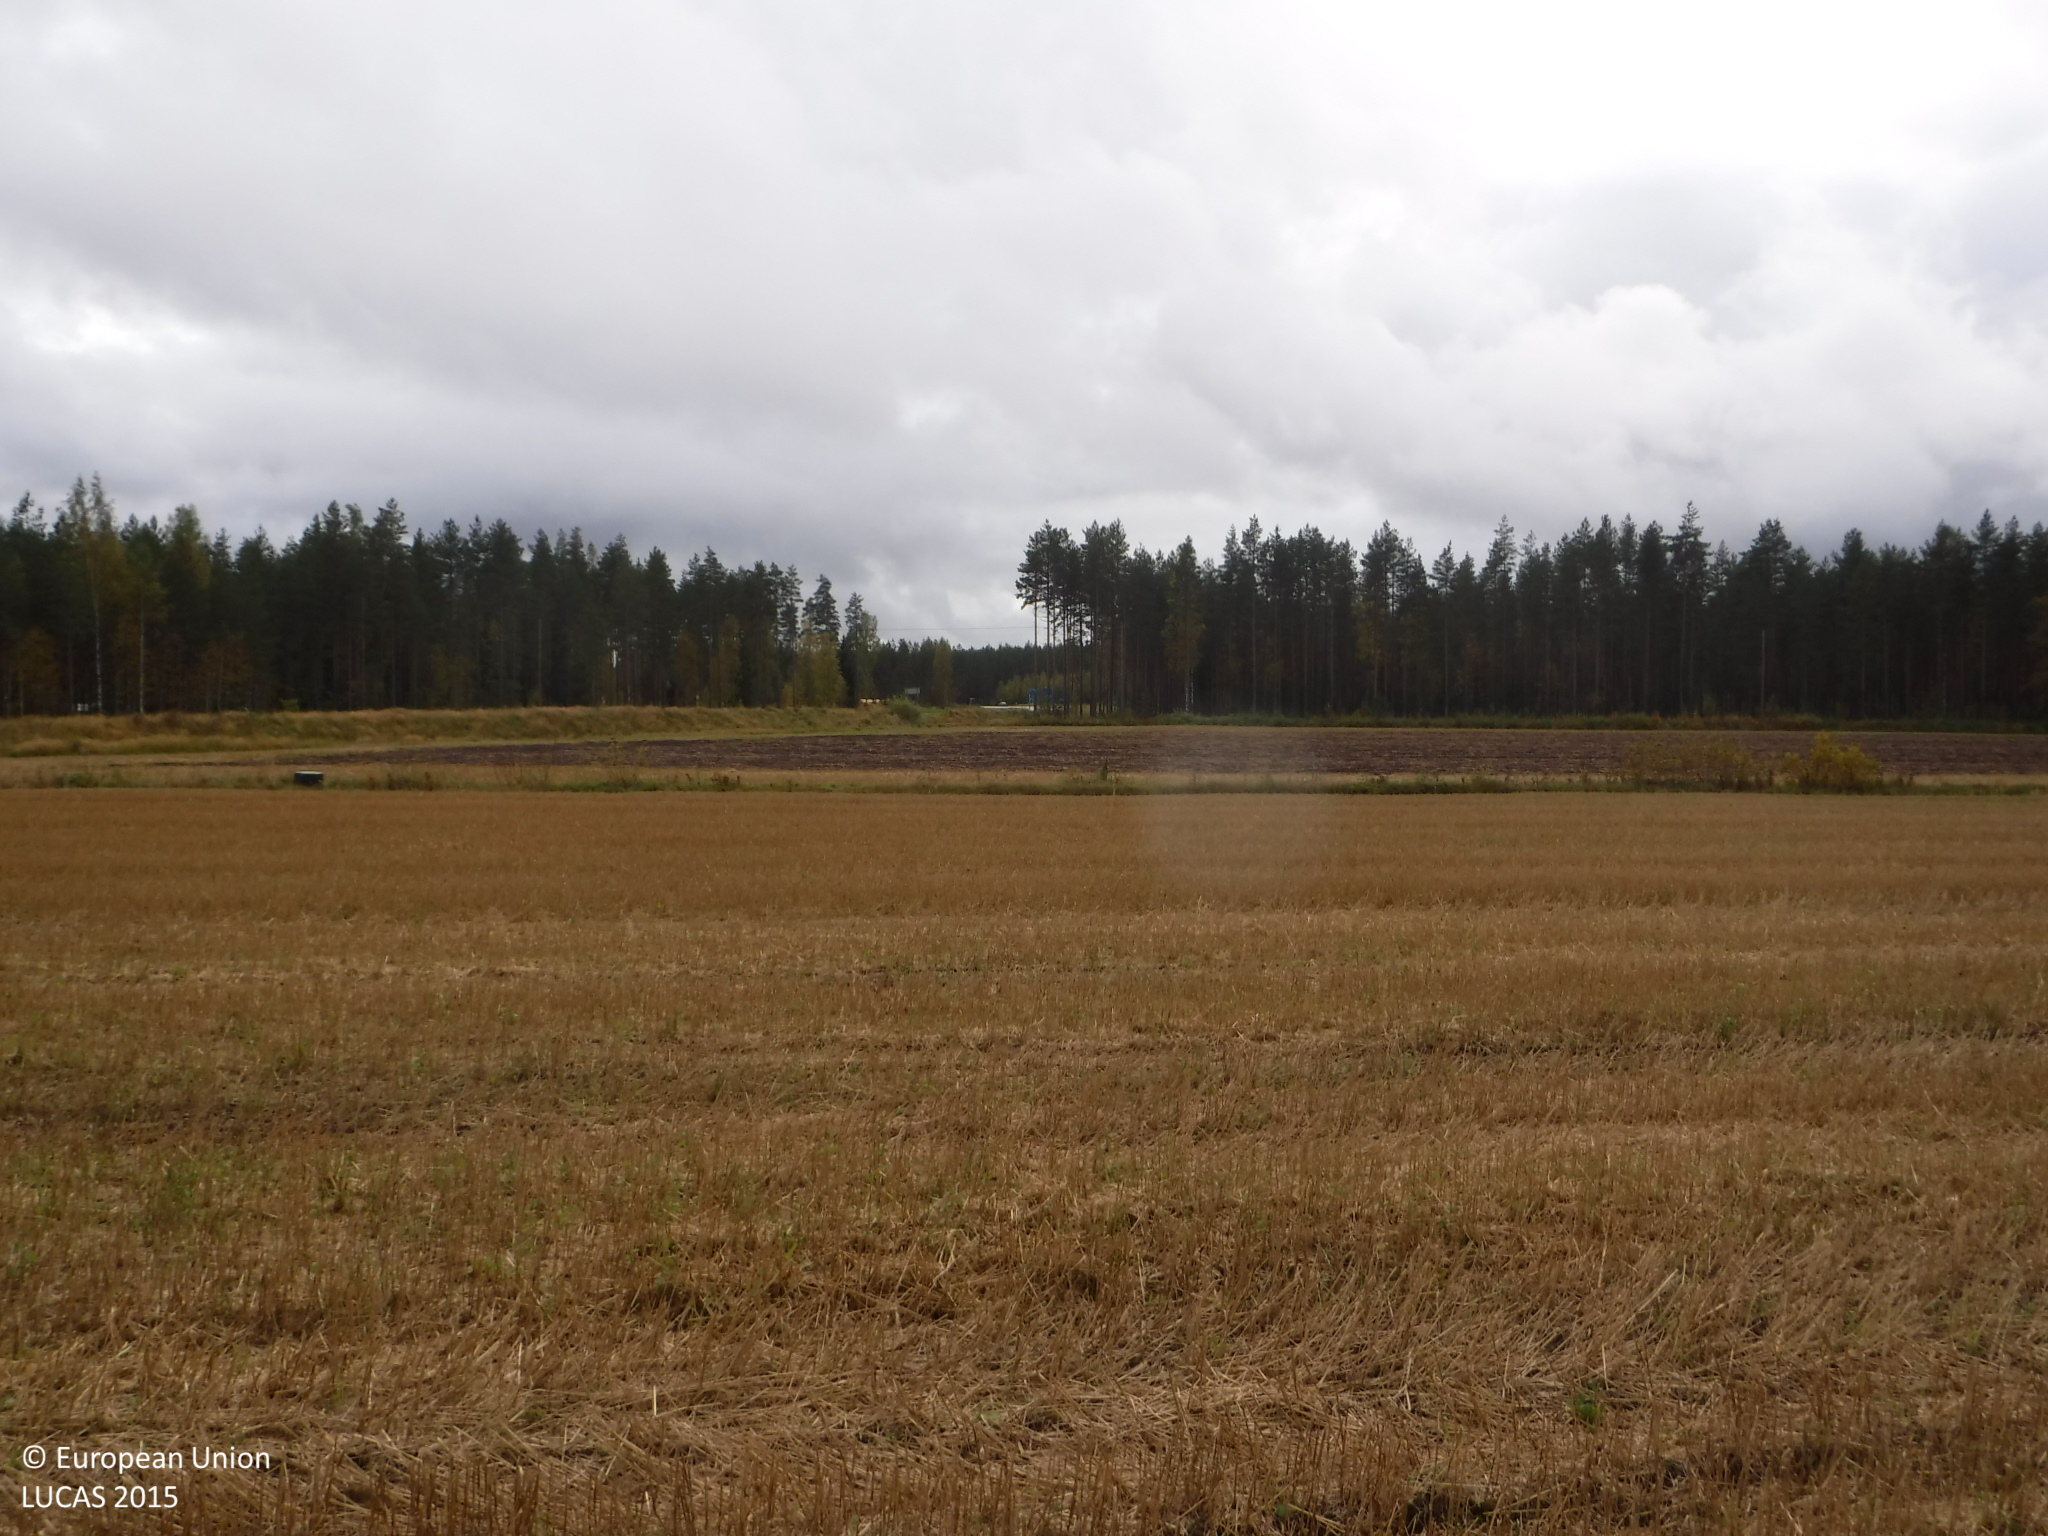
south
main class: Cropland
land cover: Barley
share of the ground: > 75 %
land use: Agriculture (excluding fallow land and kitchen gardens)
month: September
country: FI
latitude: 62.0206
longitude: 22.2267
